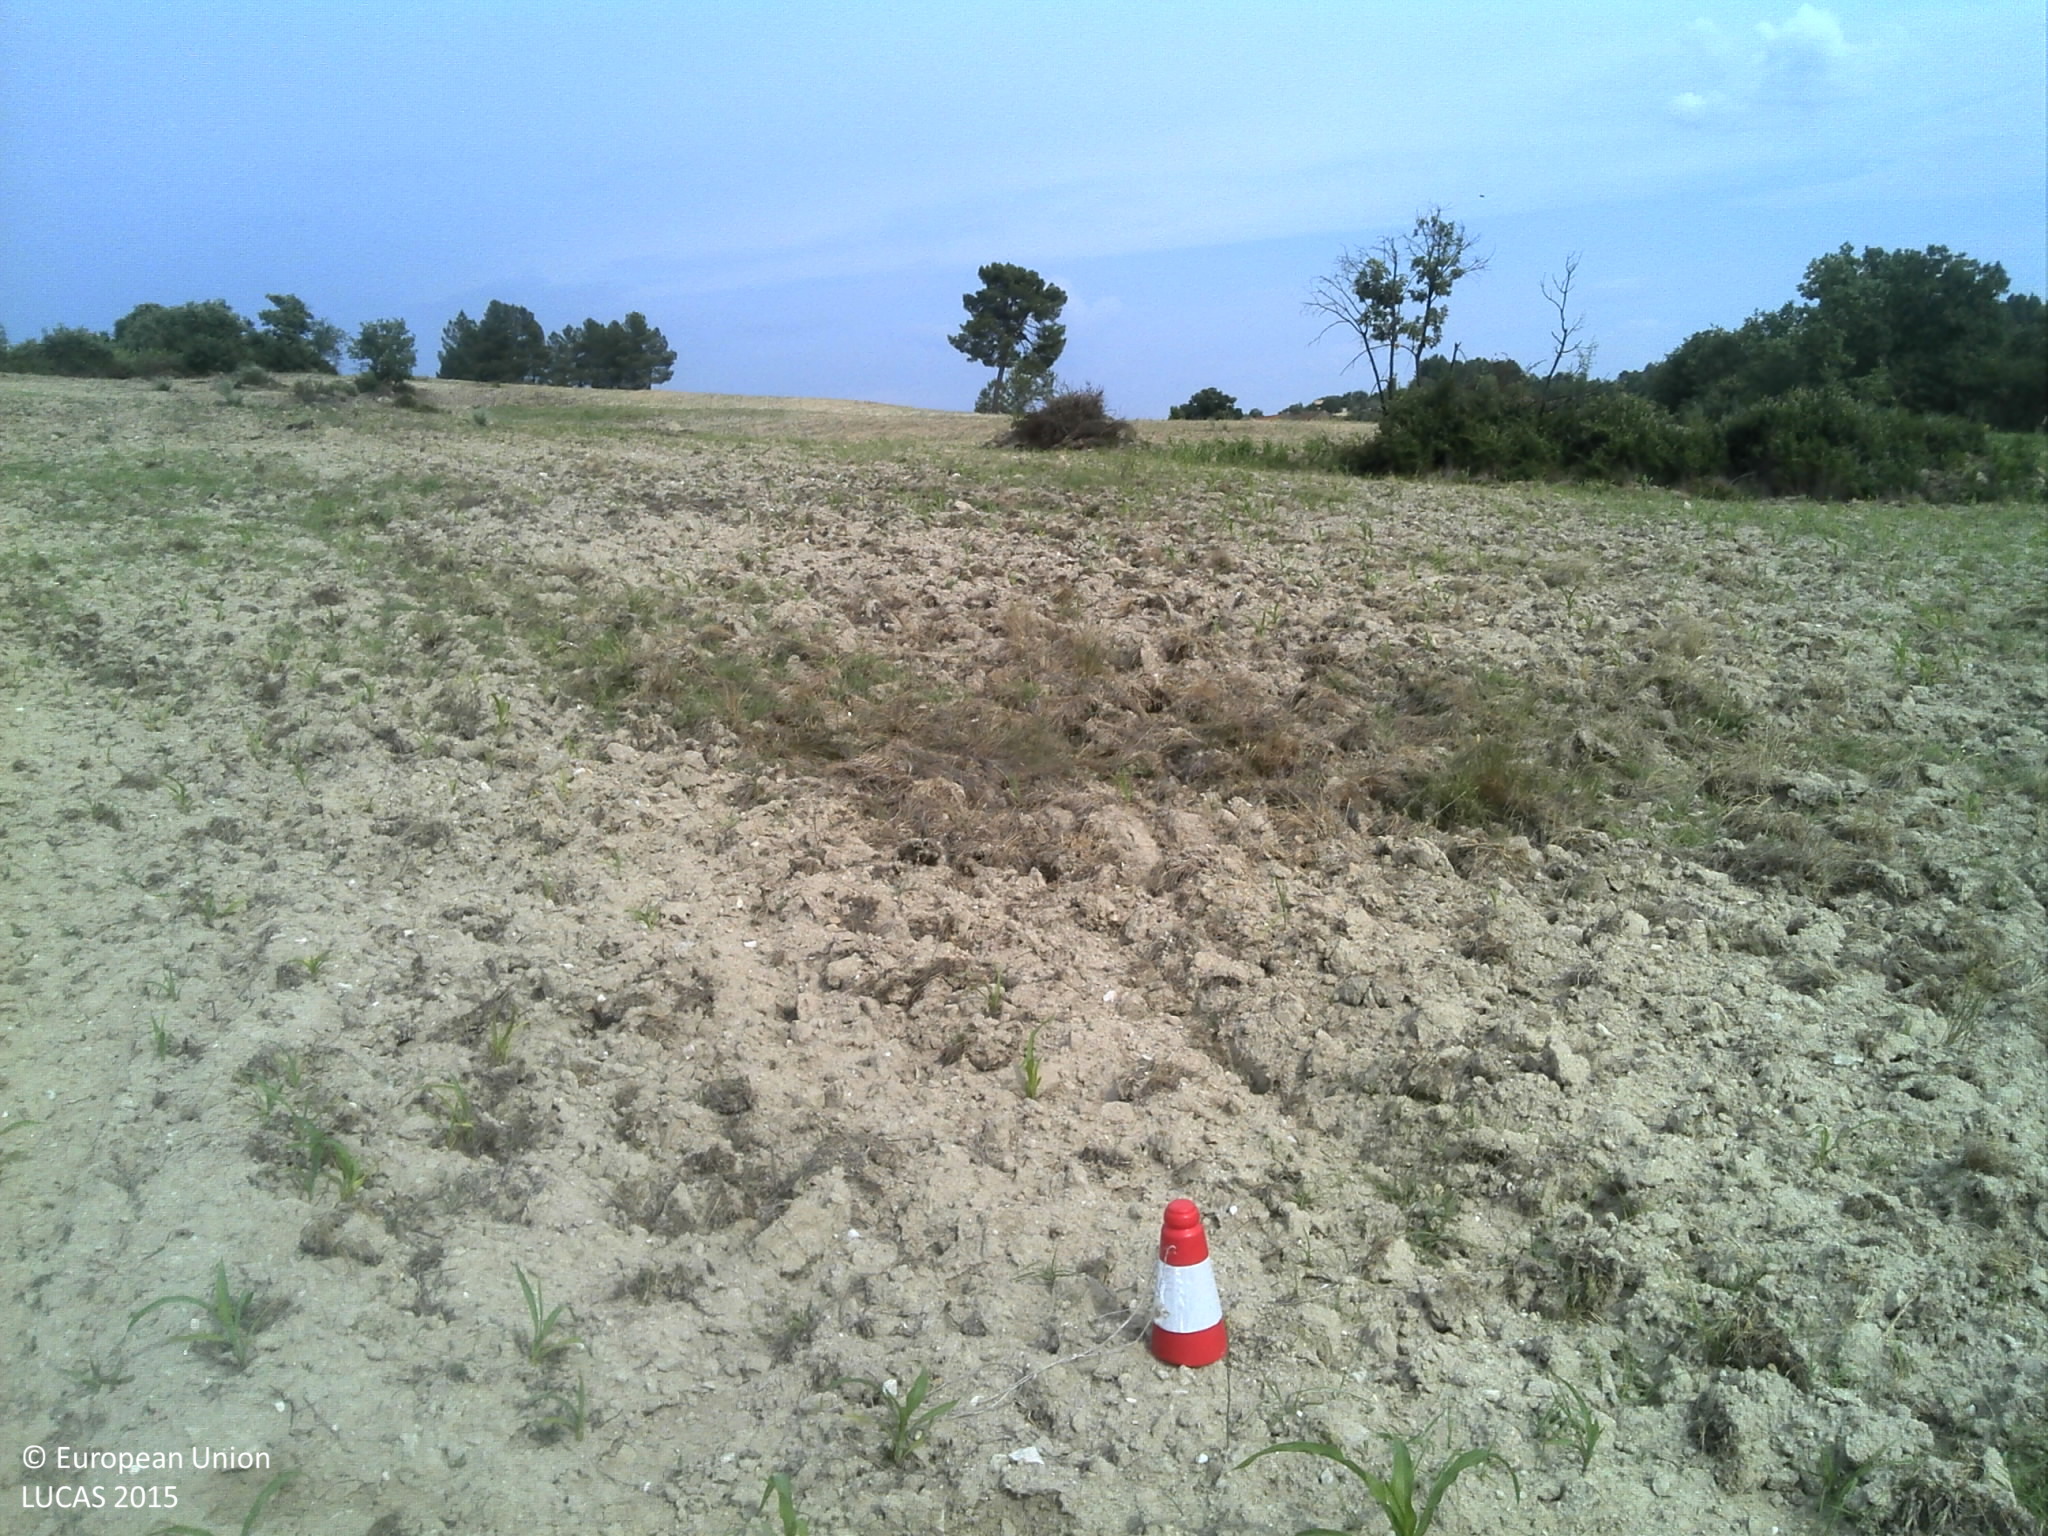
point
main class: Cropland
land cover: Maize
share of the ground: < 10 %
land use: Agriculture (excluding fallow land and kitchen gardens)
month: June
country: PT
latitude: 40.2712
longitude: -7.3794
